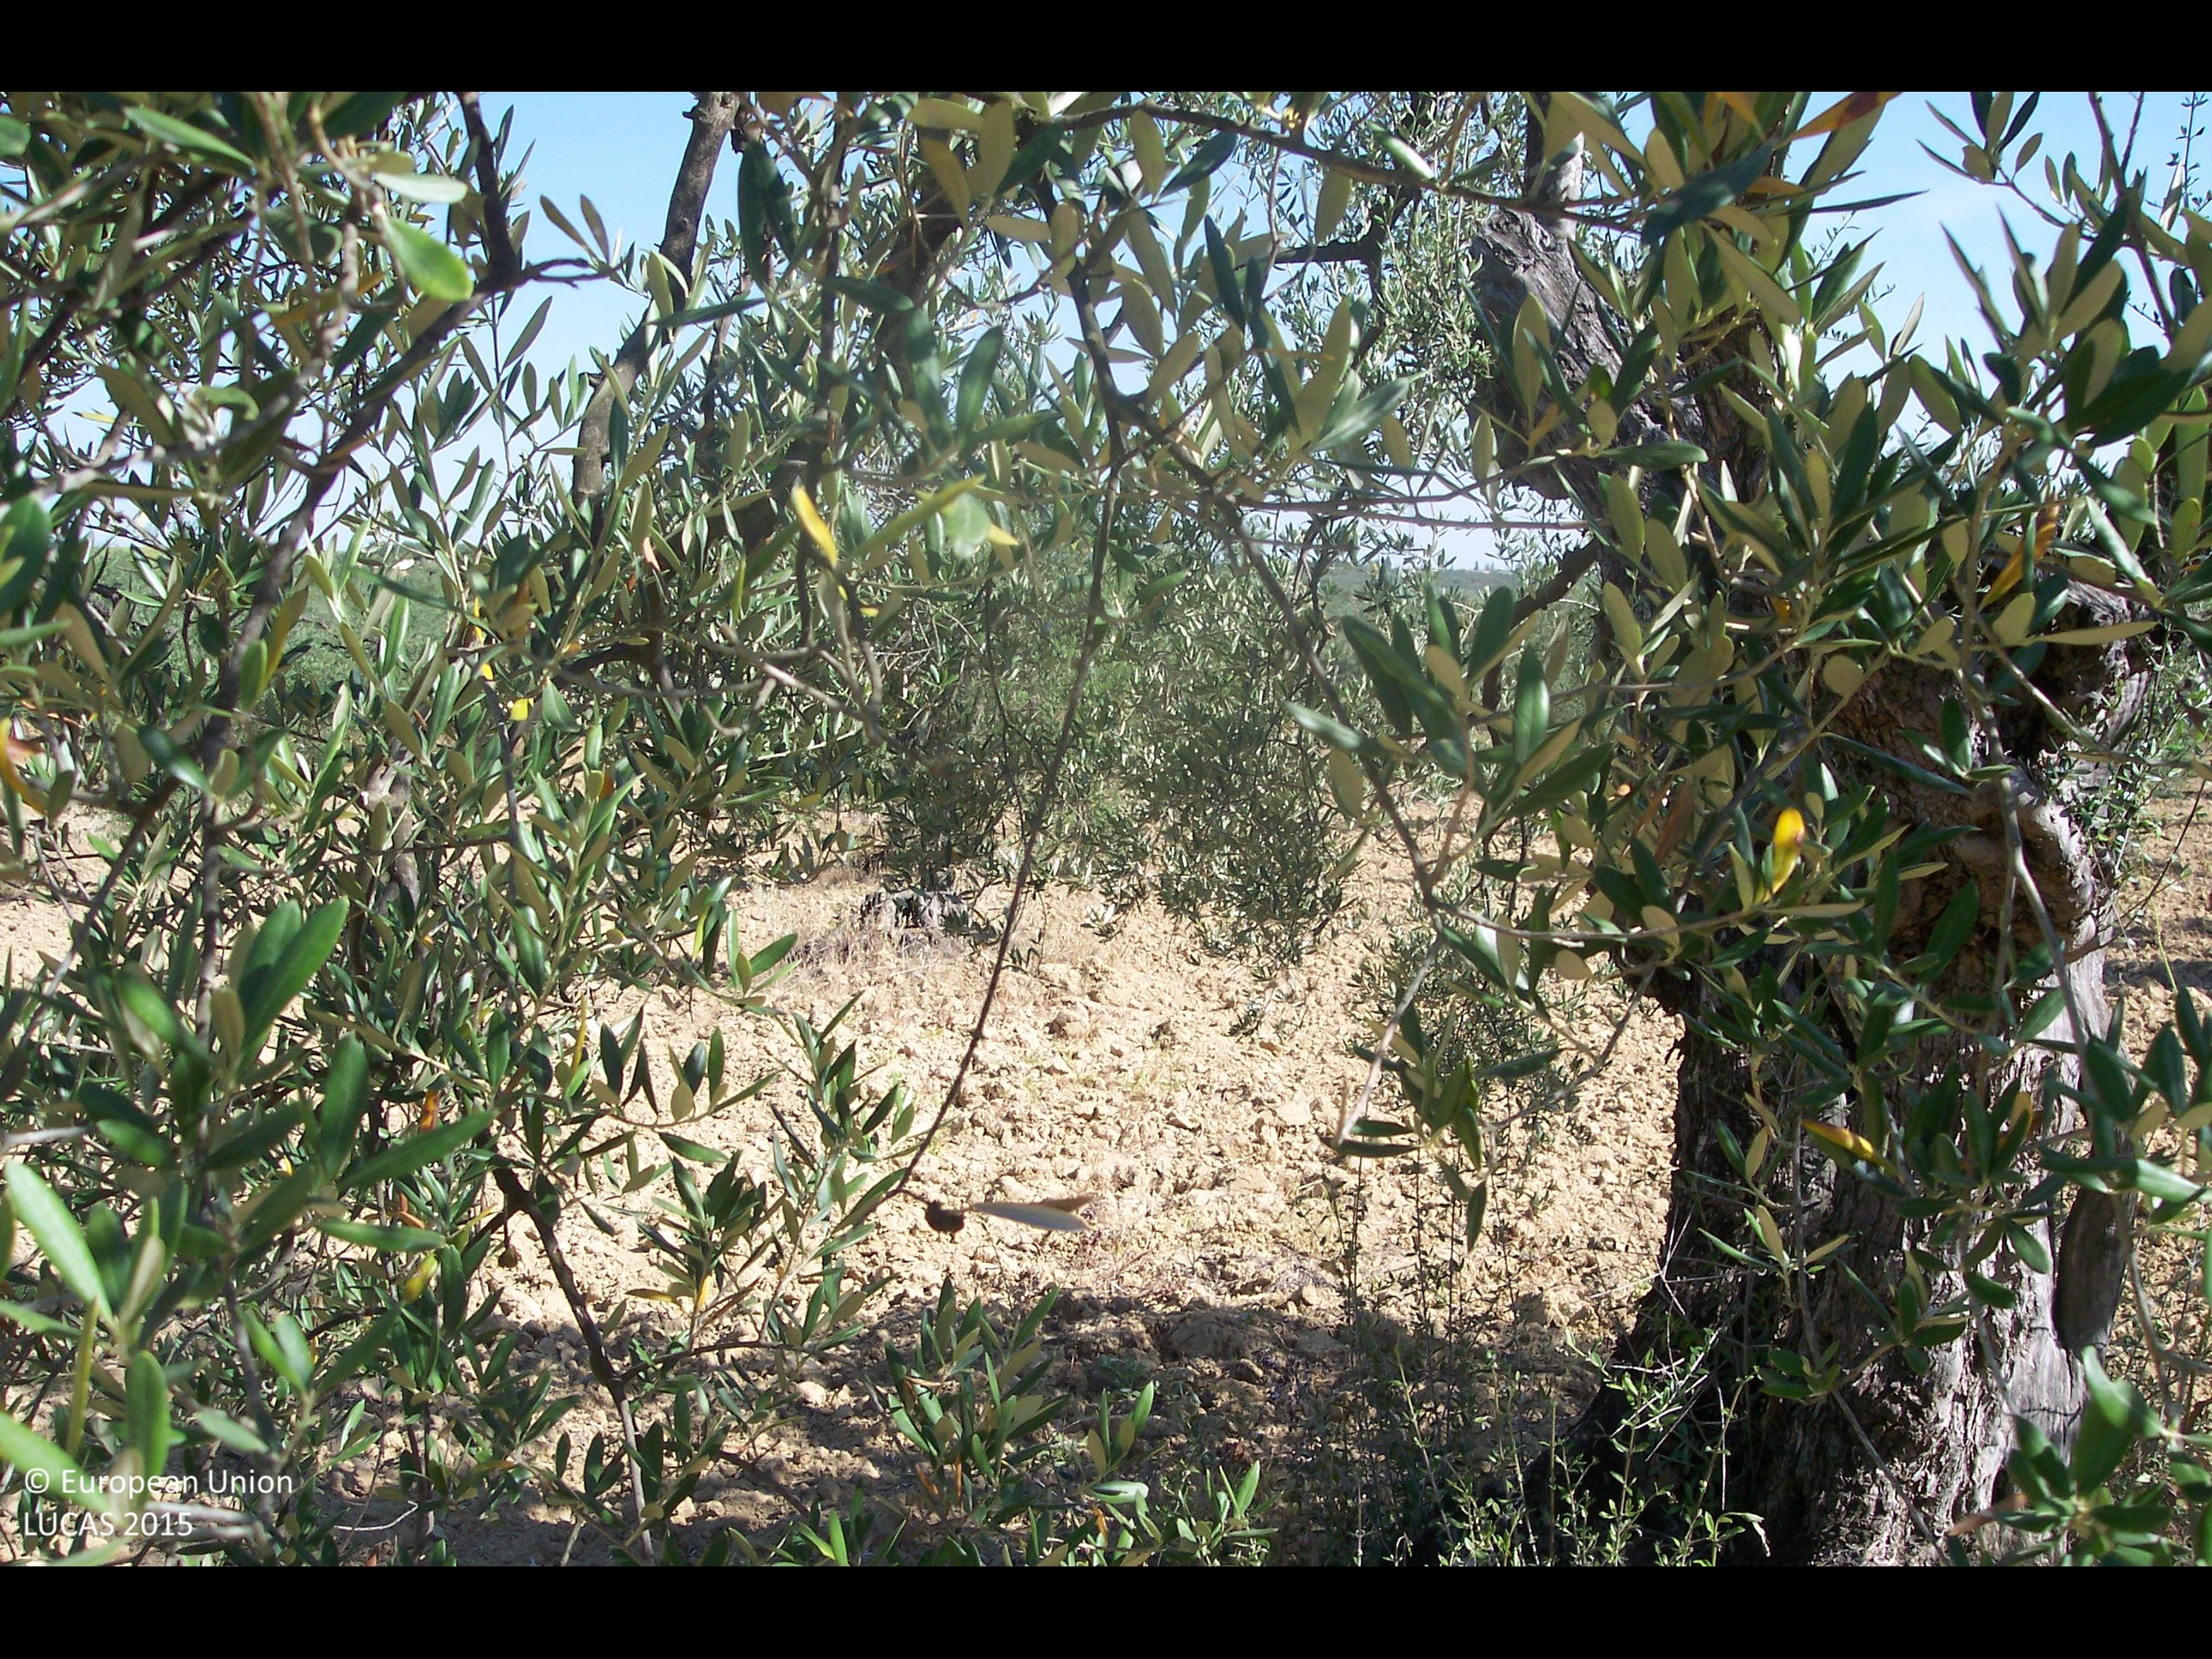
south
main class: Cropland
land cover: Olive groves
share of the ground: 25 - 50 %
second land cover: Other bare soil
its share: > 75 %
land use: Agriculture (excluding fallow land and kitchen gardens)
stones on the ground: < 10 %
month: June
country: ES
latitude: 37.3809
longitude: -6.0961
